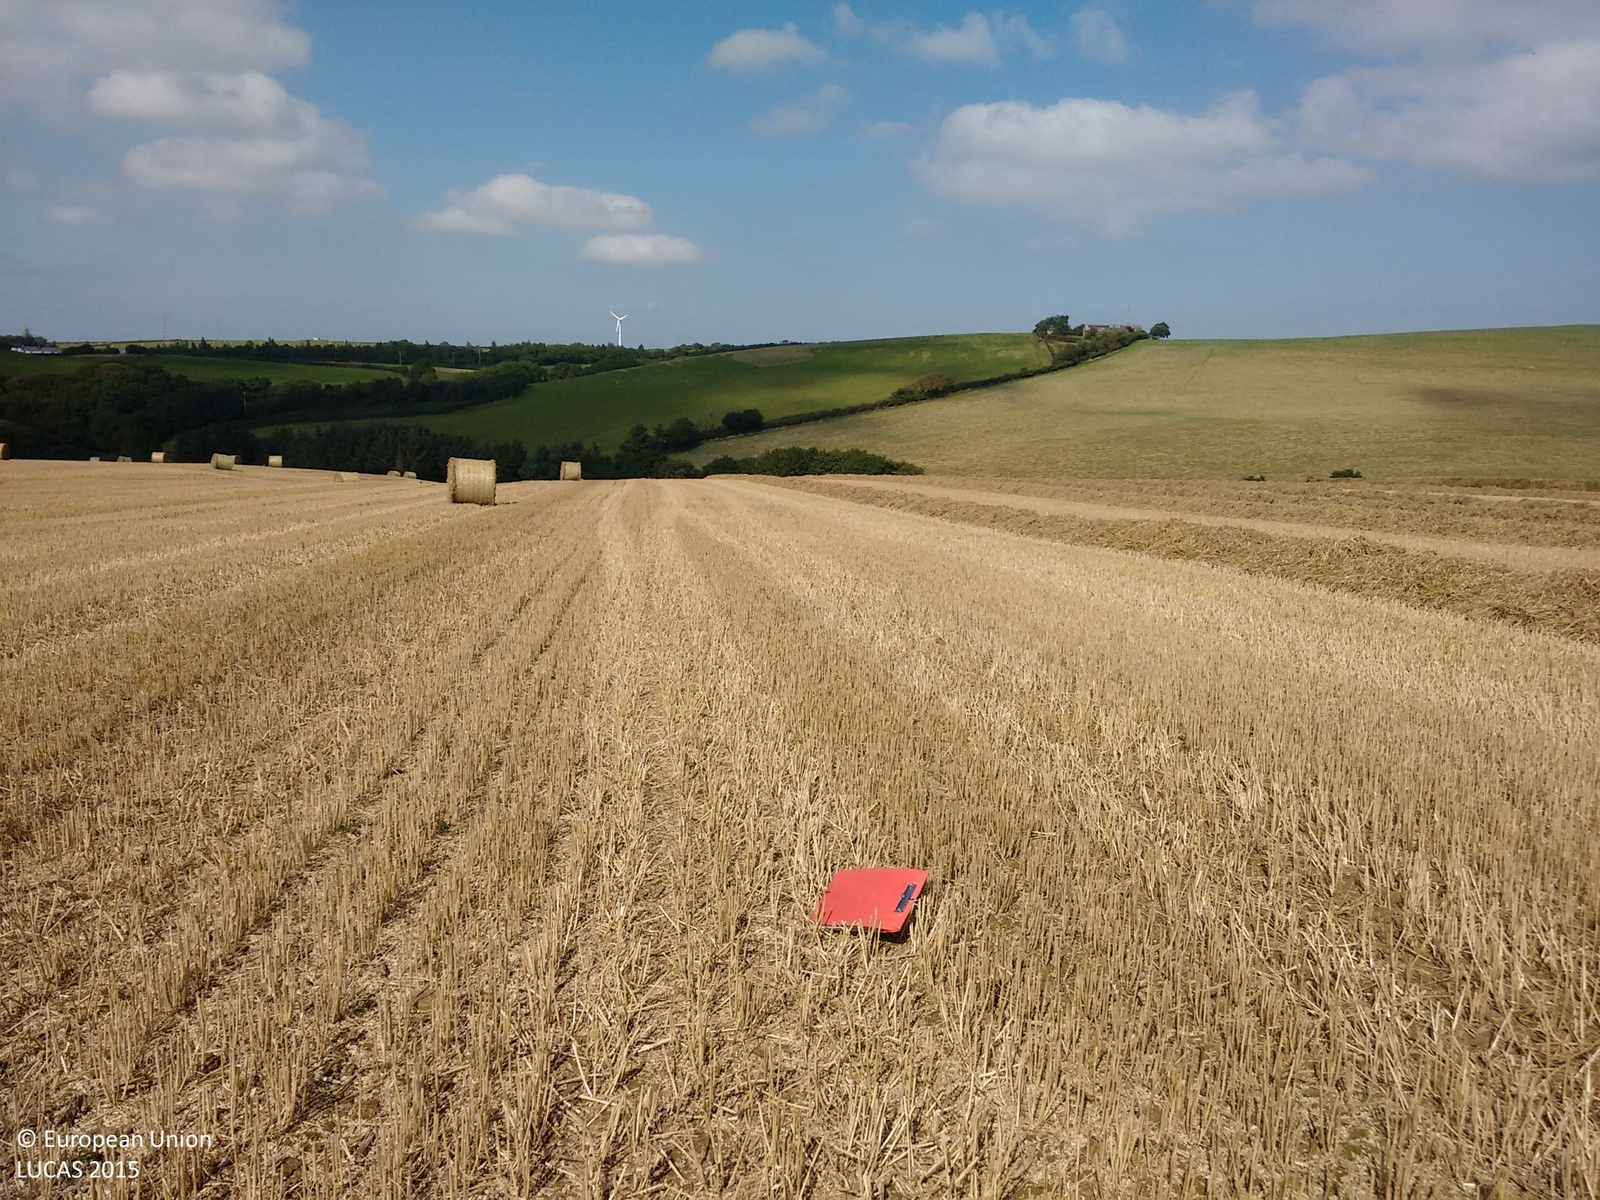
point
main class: Cropland
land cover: Barley
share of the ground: < 10 %
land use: Agriculture (excluding fallow land and kitchen gardens)
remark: Harvested field
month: September
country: GB
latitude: 51.0318
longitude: -4.1429
